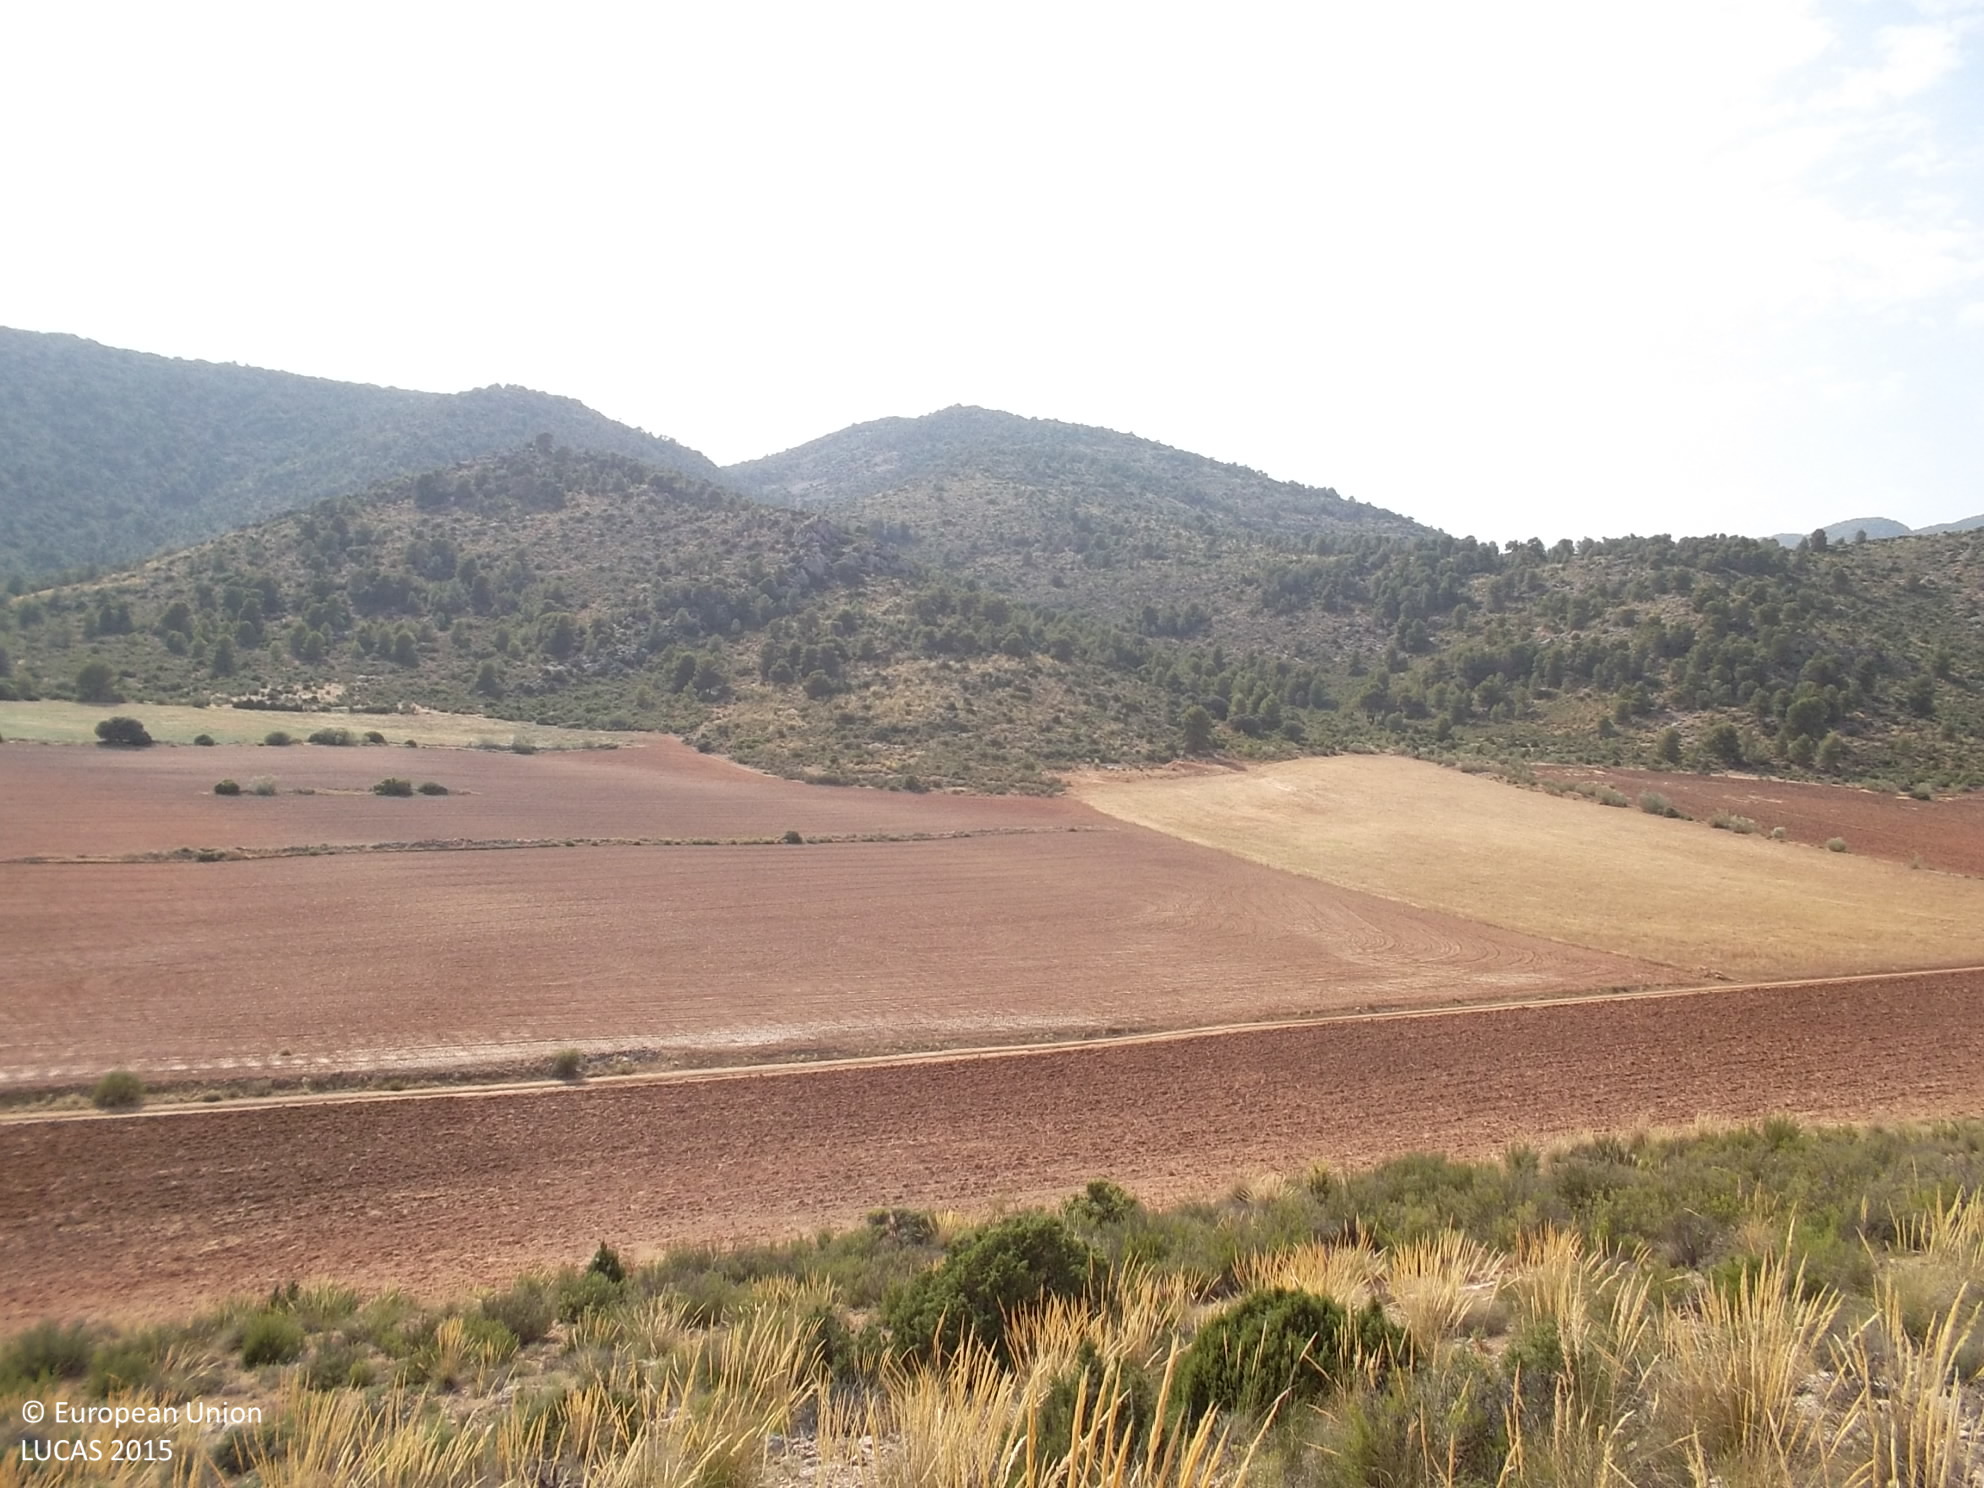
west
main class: Shrubland
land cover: Shrubland without tree cover
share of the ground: 50 - 75 %
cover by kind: shrubs 60 %, herbaceous plants 20 %, consolidated bare surface 20 %
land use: Semi-natural and natural areas not in use
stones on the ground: 25 - 50 %
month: July
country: ES
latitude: 37.8980
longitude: -2.4430
